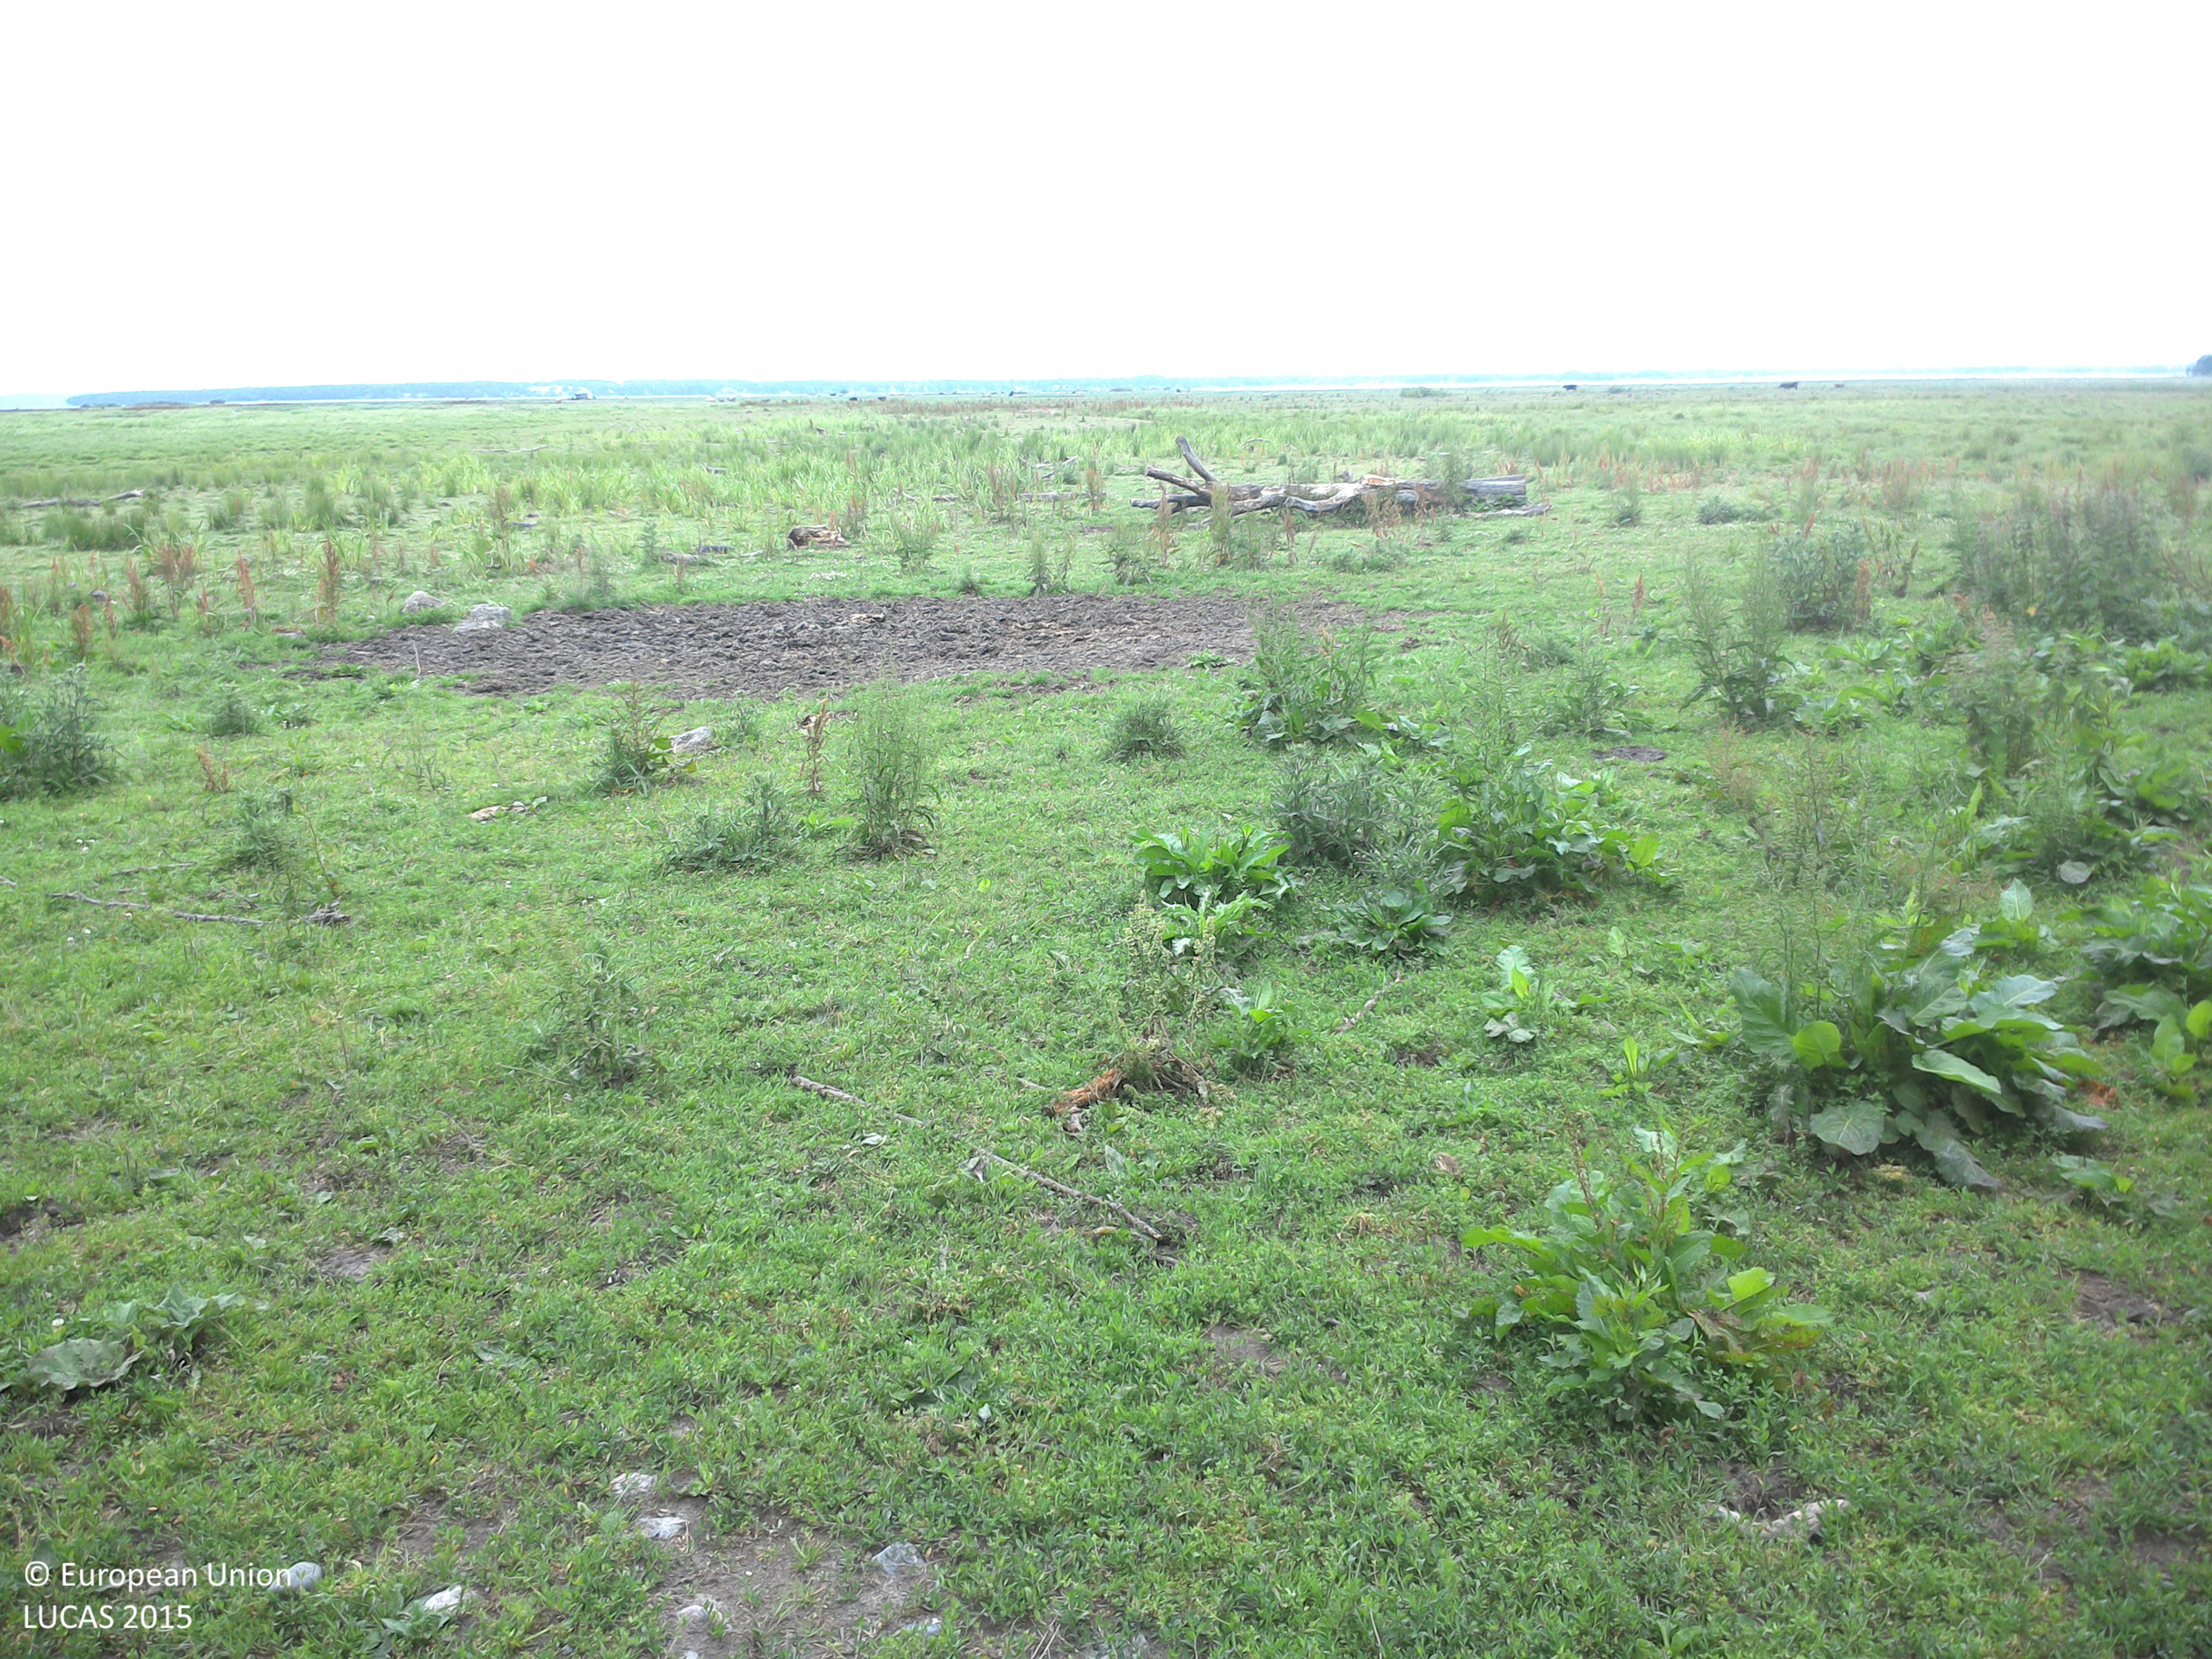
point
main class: Grassland
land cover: Grassland without tree/shrub cover
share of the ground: > 75 %
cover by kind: herbaceous plants 100 %
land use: Agriculture (excluding fallow land and kitchen gardens)
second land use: Amenities, museums, leisure
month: June
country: SE
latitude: 58.4650
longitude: 15.5655
